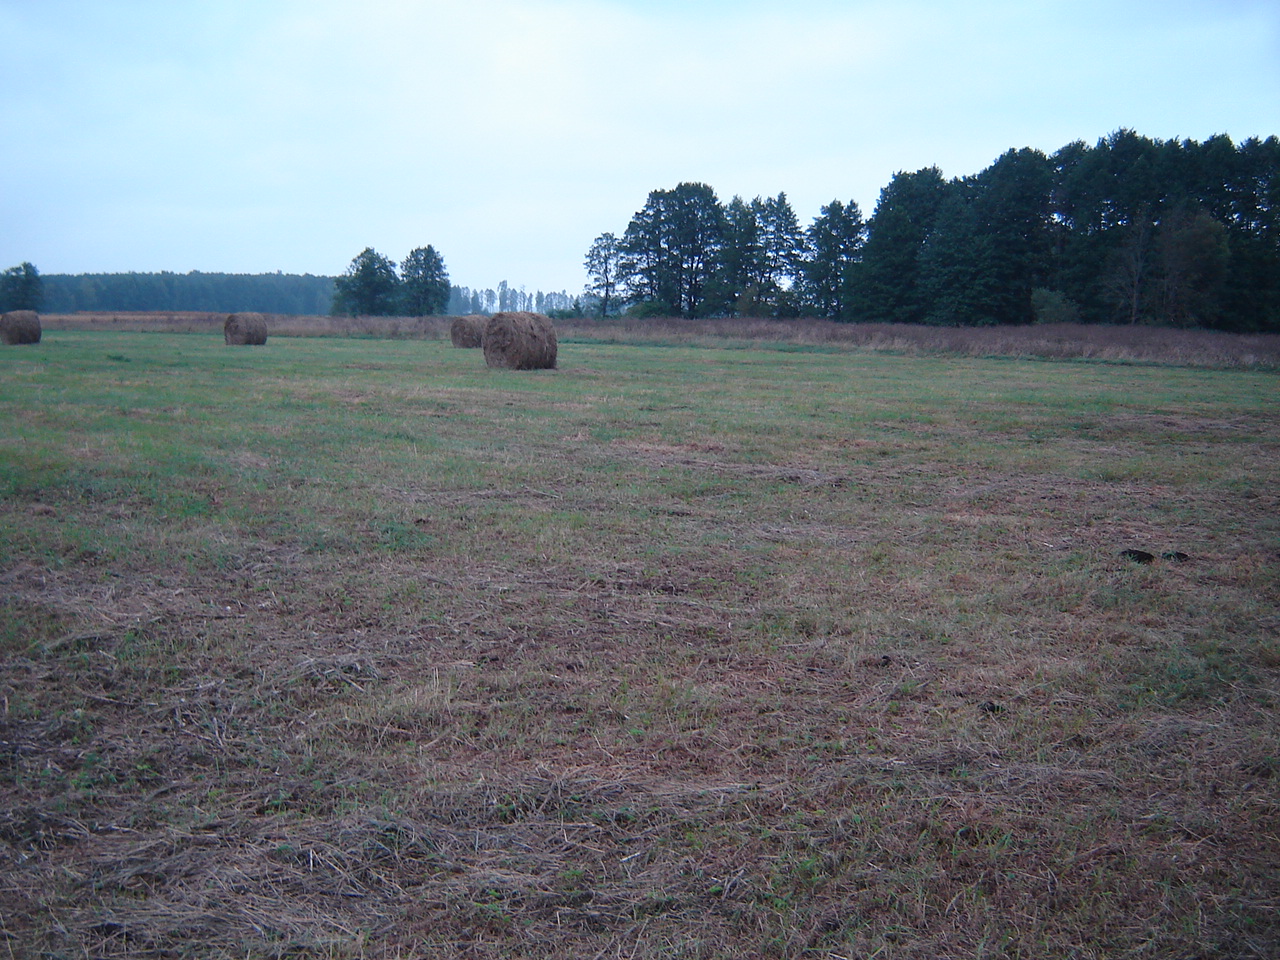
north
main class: Grassland
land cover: Grassland without tree/shrub cover
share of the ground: > 75 %
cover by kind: herbaceous plants 100 %
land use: Agriculture (excluding fallow land and kitchen gardens)
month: September
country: LT
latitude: 54.3868
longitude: 24.8165
